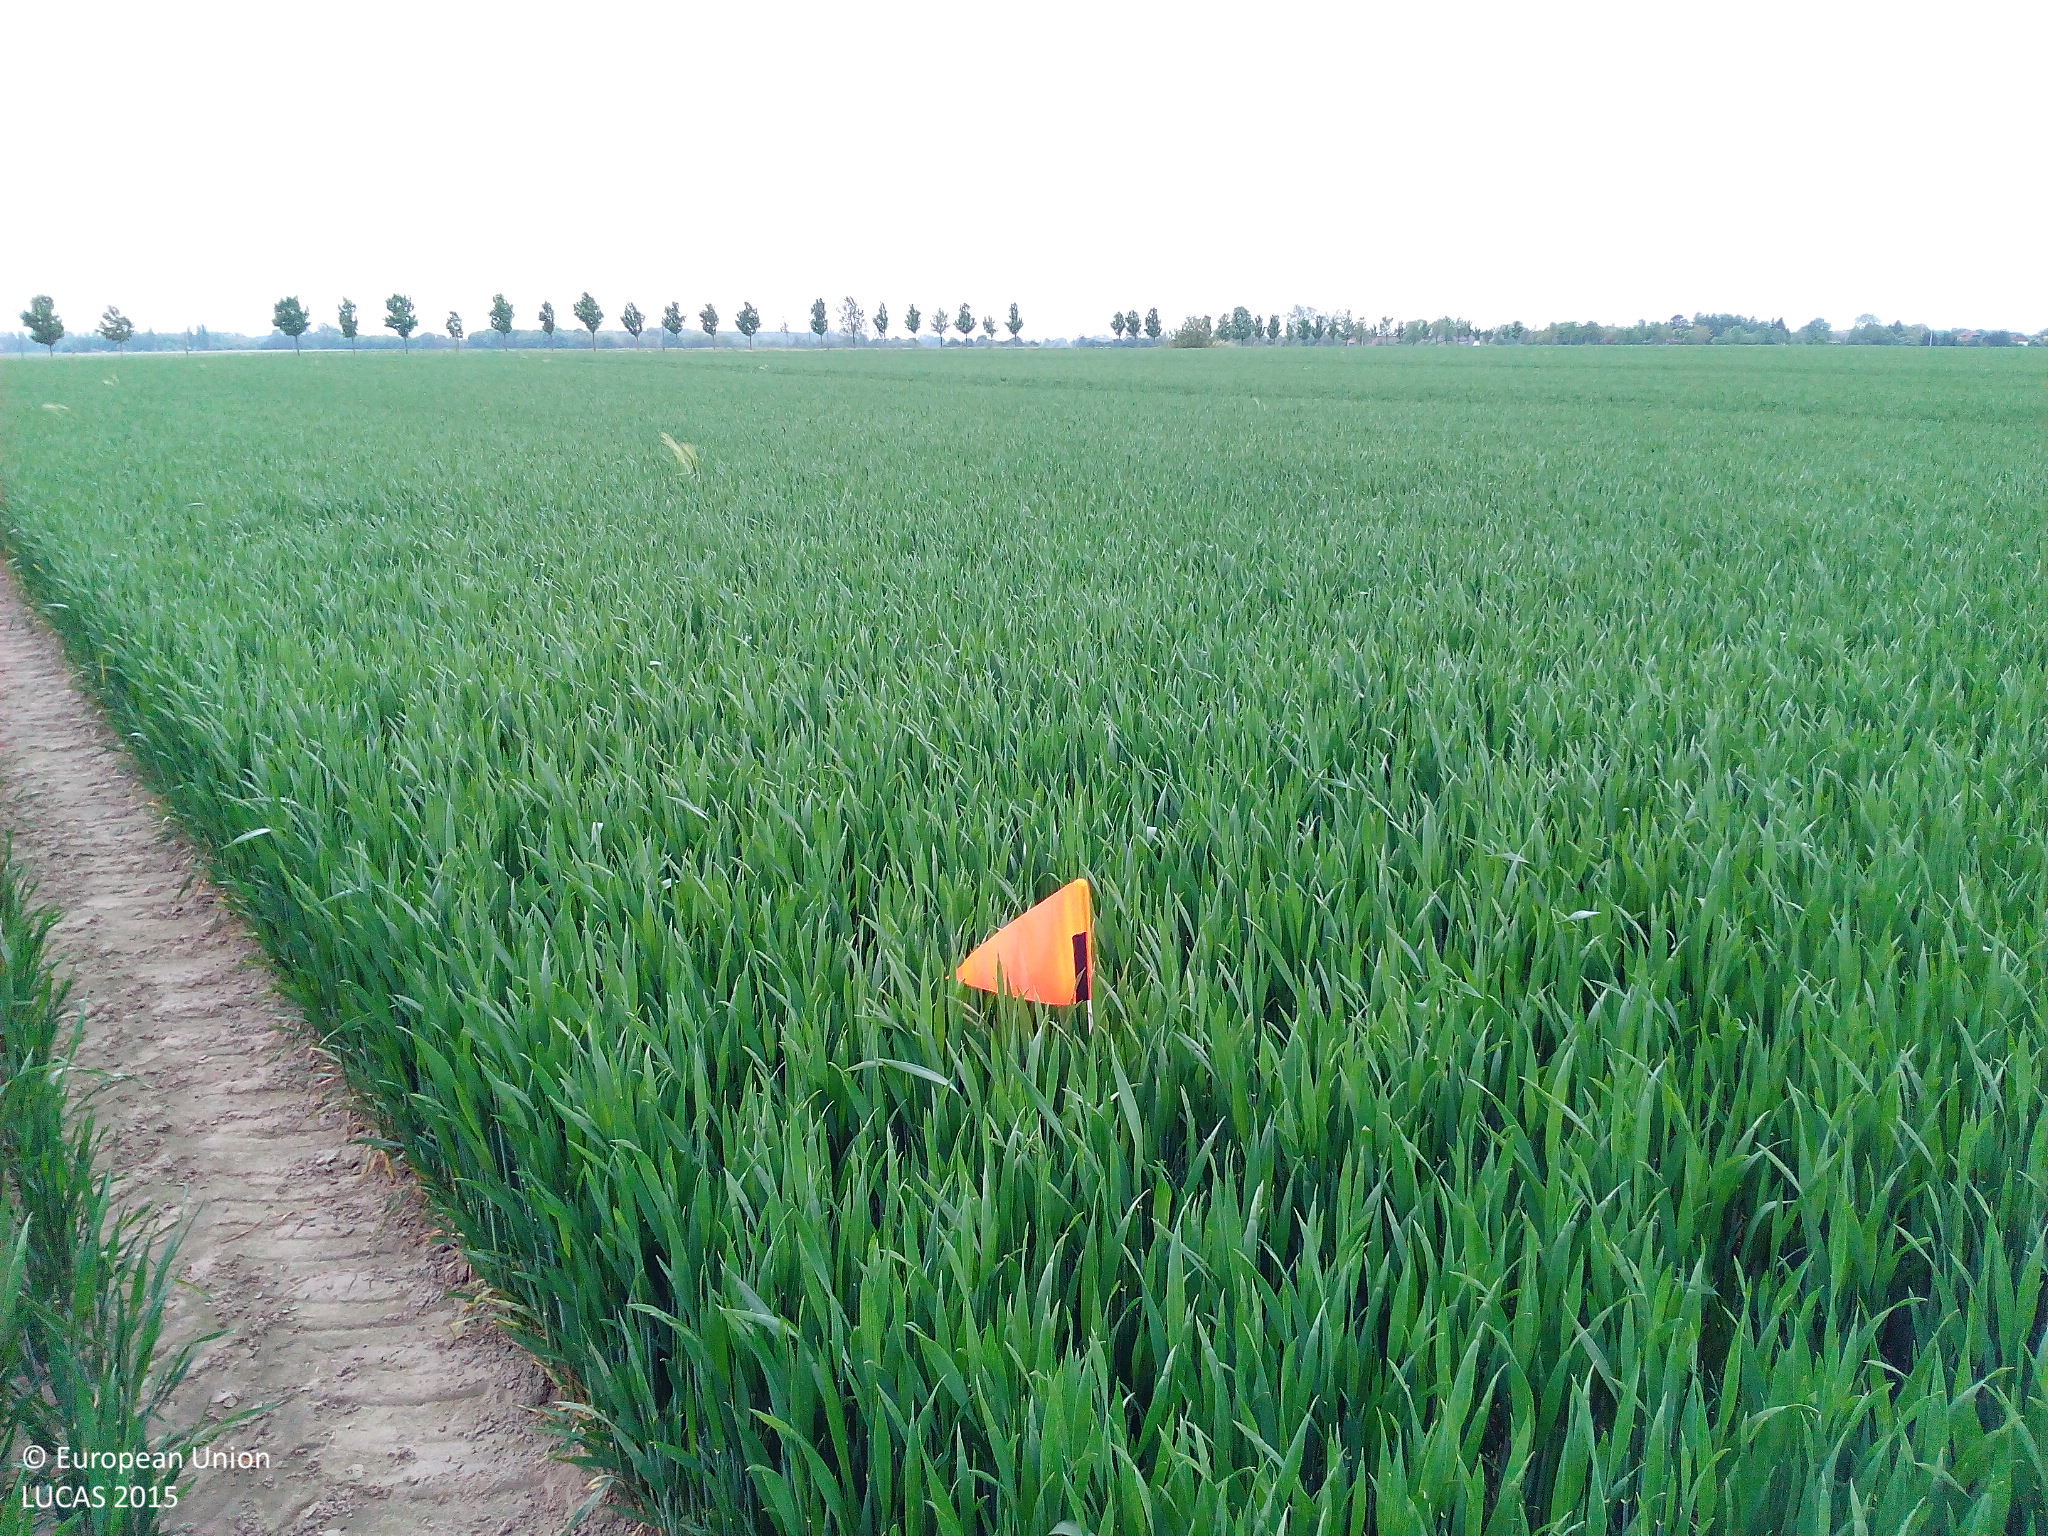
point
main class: Cropland
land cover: Barley
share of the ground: > 75 %
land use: Agriculture (excluding fallow land and kitchen gardens)
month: May
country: DE
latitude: 54.2026
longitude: 13.2952
